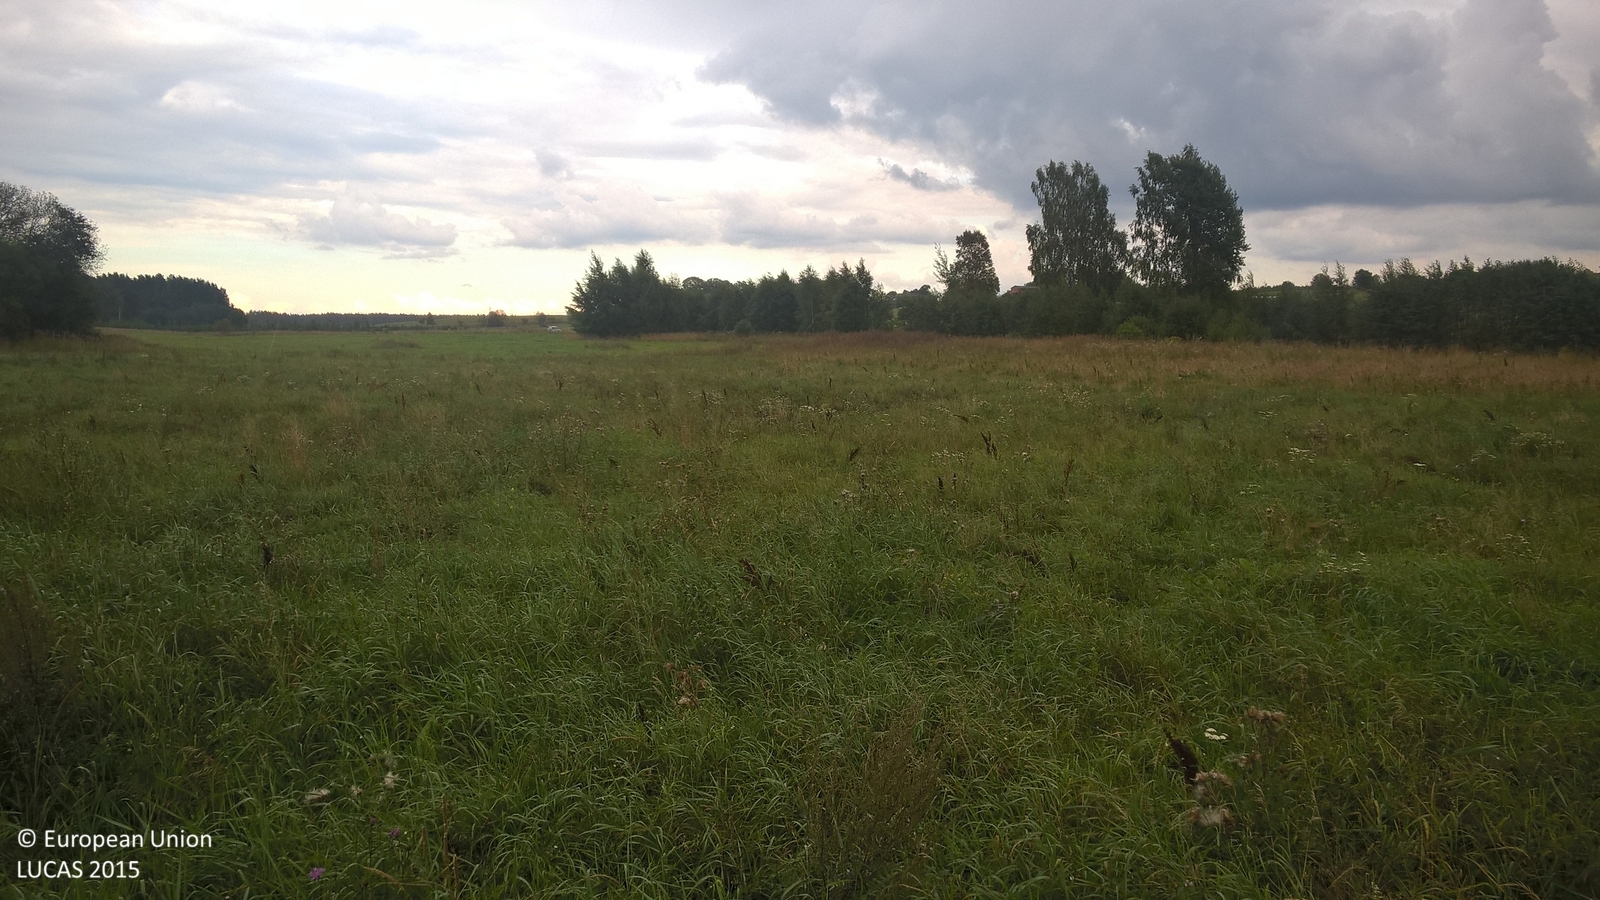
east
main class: Grassland
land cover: Spontaneously vegetated surfaces
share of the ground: > 75 %
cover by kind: herbaceous plants 100 %
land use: Fallow land
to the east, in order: Spontaneously vegetated surfaces; Grassland without tree/shrub cover; Broadleaved woodland; Fences; Tracks; Fences; Broadleaved woodland; Ditches and canals; Abandoned hedges; Grassland without tree/shrub cover
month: September
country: LV
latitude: 57.3598
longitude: 25.5606
